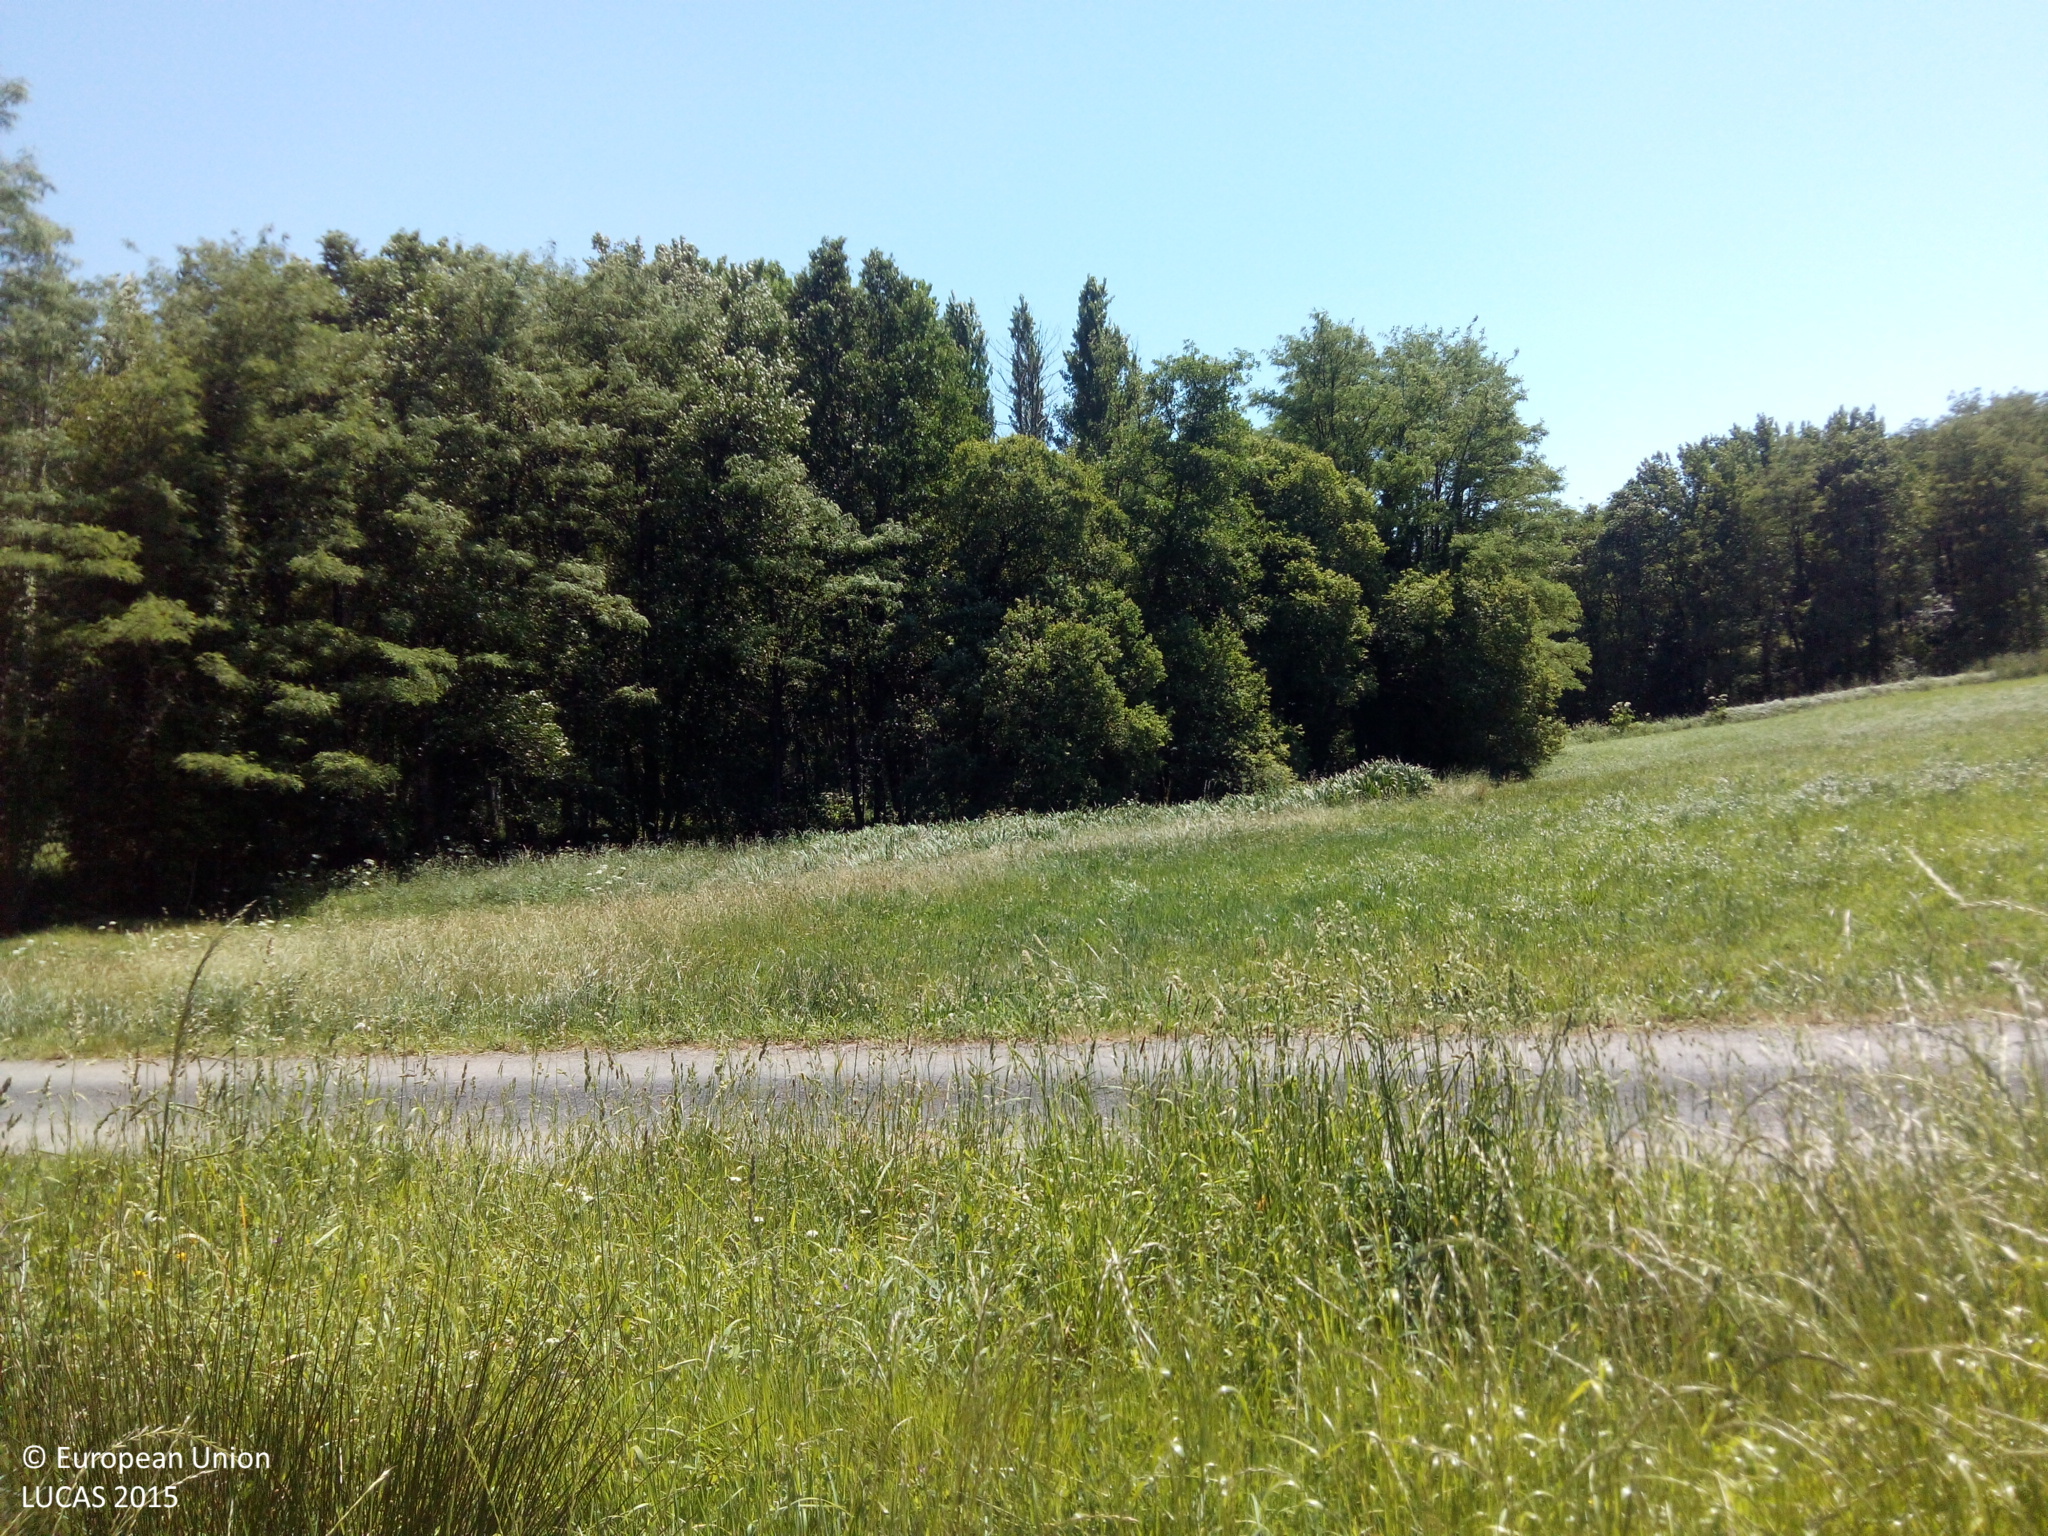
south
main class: Cropland
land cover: Temporary grasslands
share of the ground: > 75 %
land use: Agriculture (excluding fallow land and kitchen gardens)
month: May
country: ES
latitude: 42.7716
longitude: -8.4448
